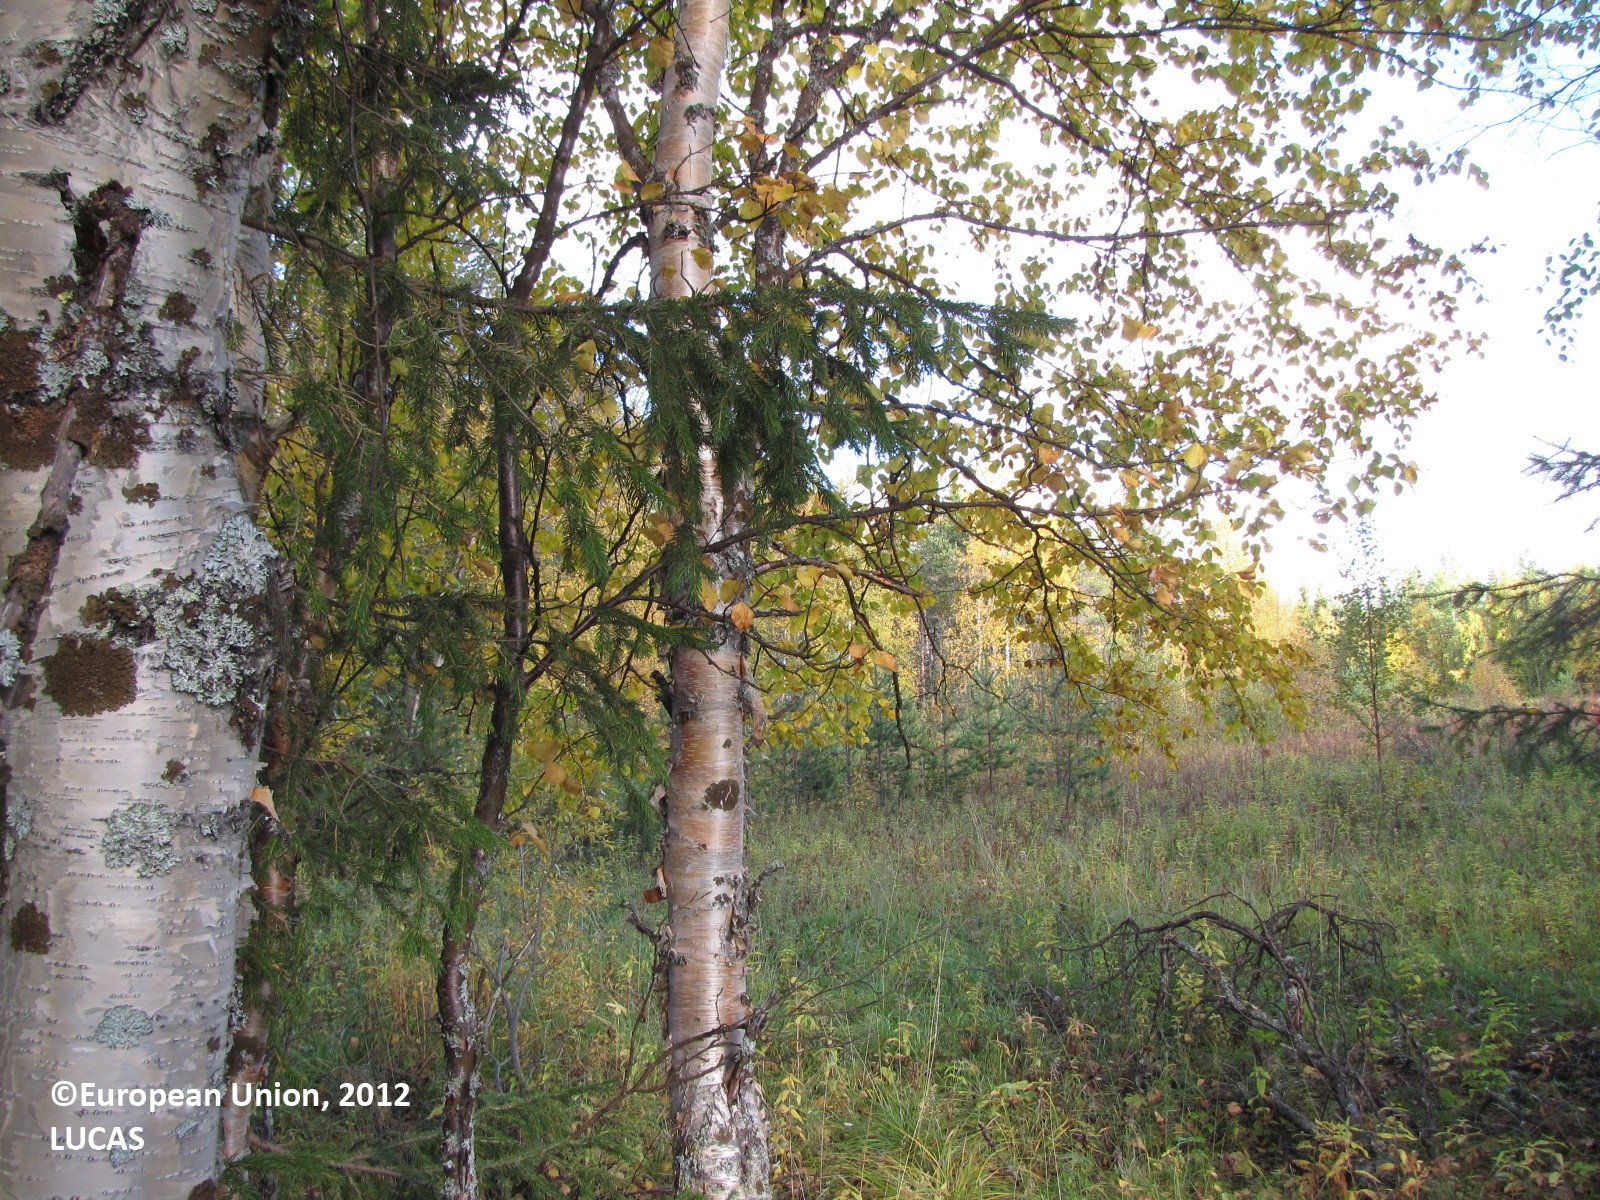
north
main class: Woodland
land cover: Pine dominated mixed woodland
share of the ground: 10 - 25 %
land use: Forestry
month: September
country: FI
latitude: 67.3706
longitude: 24.8745
